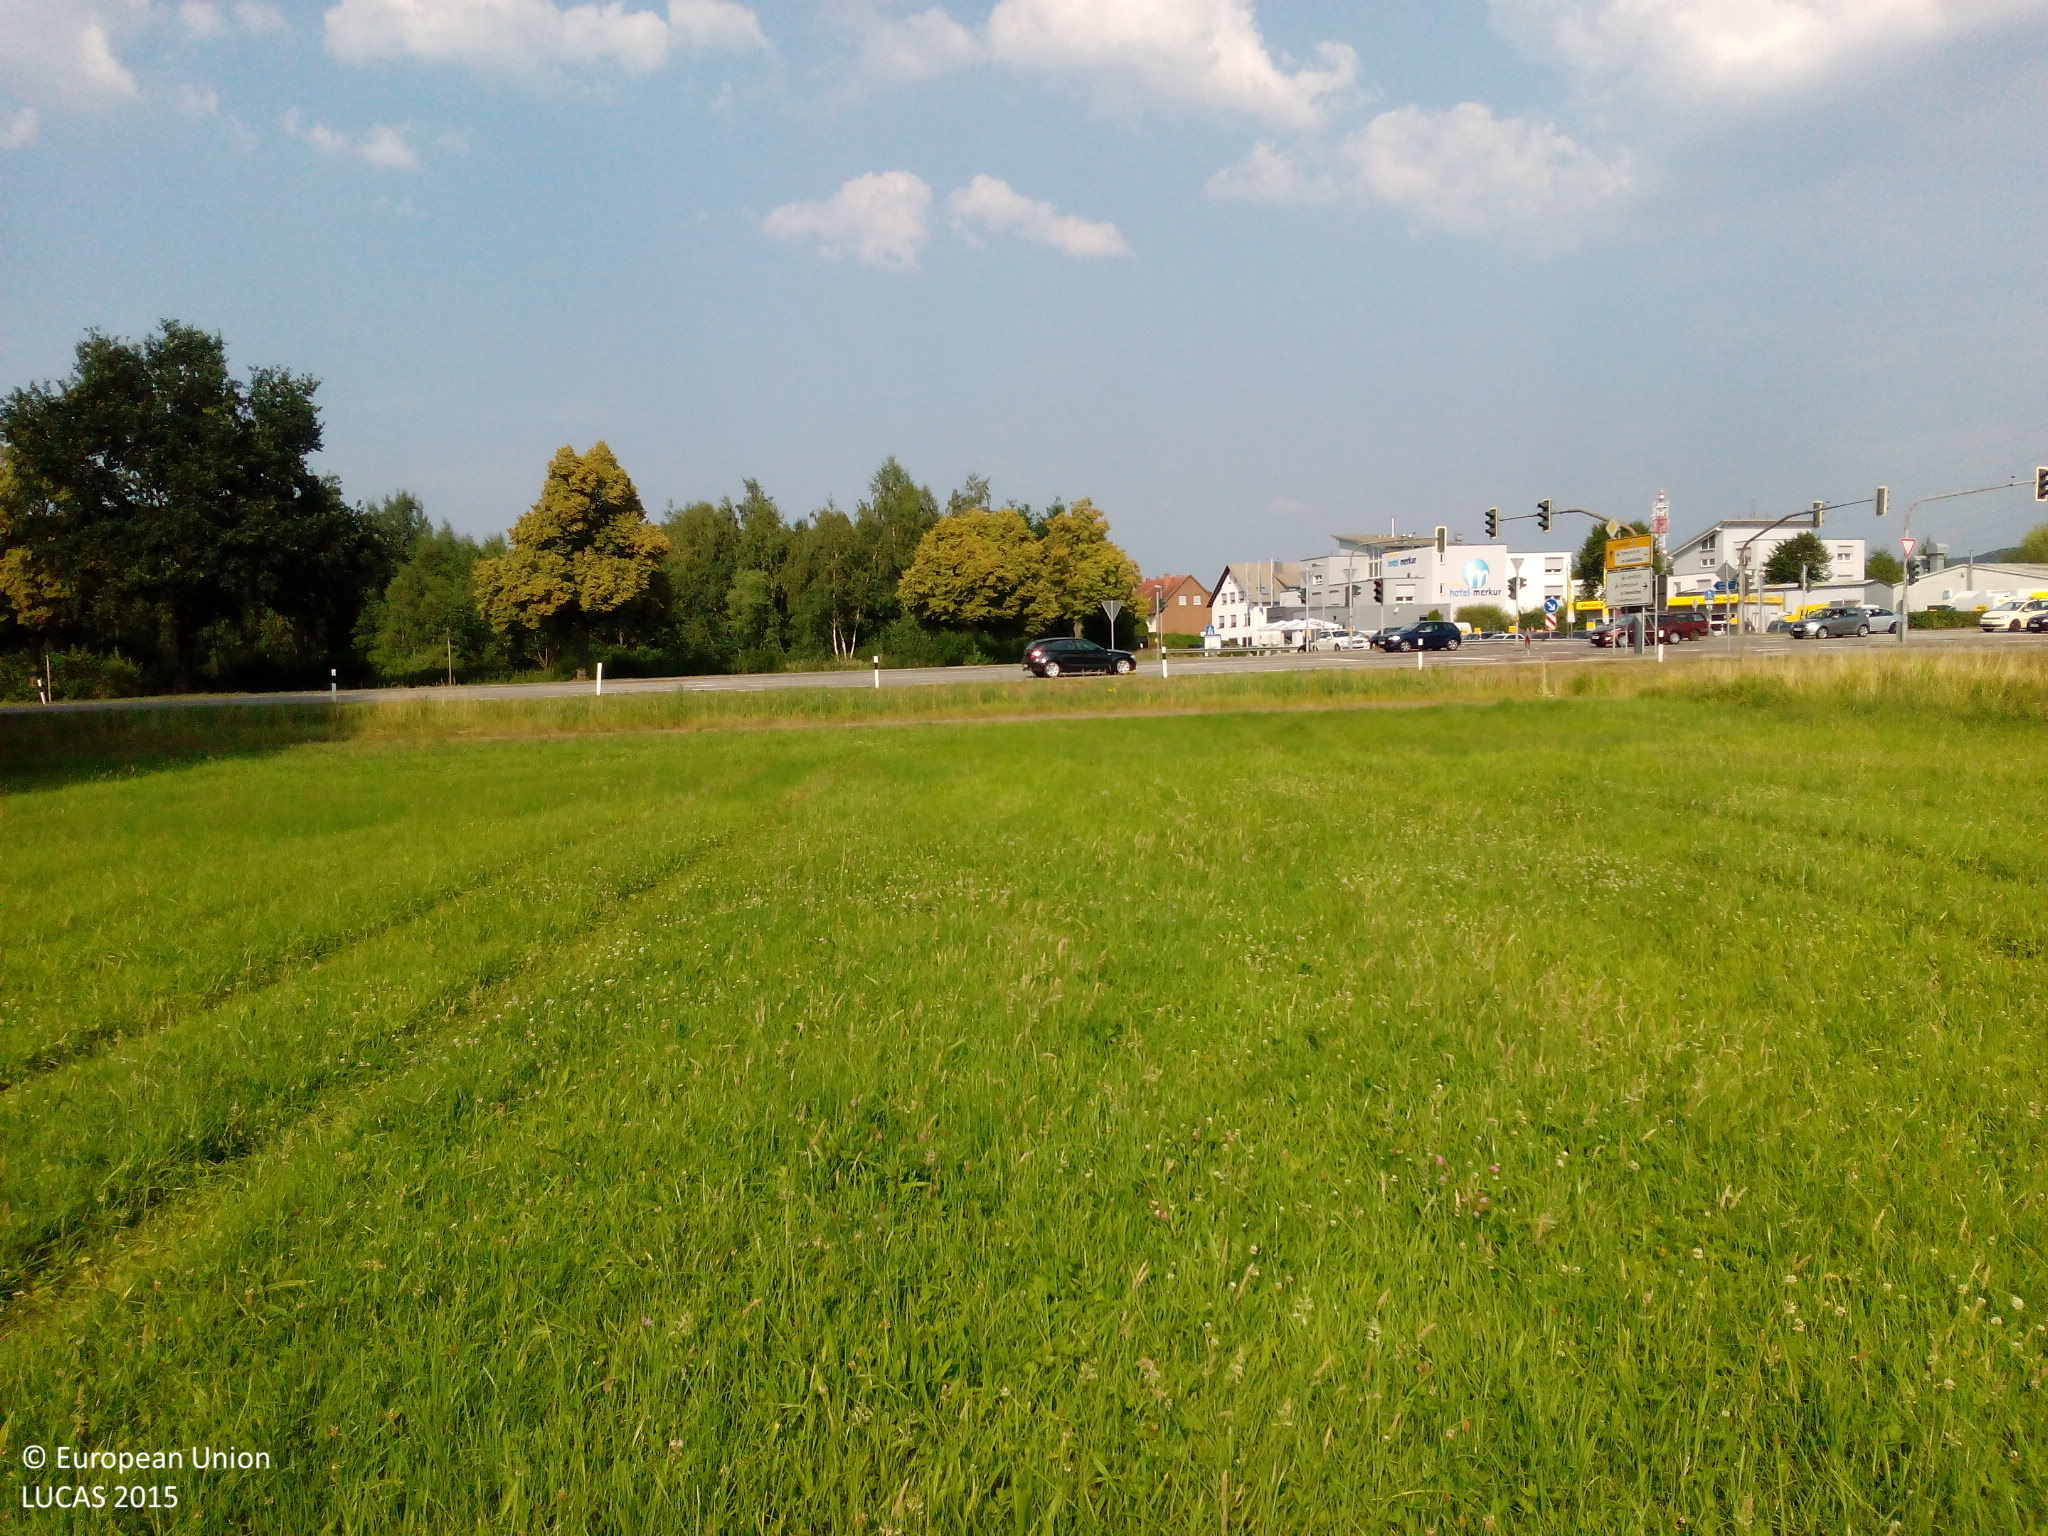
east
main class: Grassland
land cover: Grassland without tree/shrub cover
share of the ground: > 75 %
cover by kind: herbaceous plants 90 %, unconsolidated bare surface 10 %
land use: Agriculture (excluding fallow land and kitchen gardens)
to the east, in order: Grassland without tree/shrub cover; Tracks; Spontaneously vegetated surfaces; Ditches and canals; Grass margins; Artificial constructions in urban areas
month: July
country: DE
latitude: 49.4205
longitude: 7.5604
